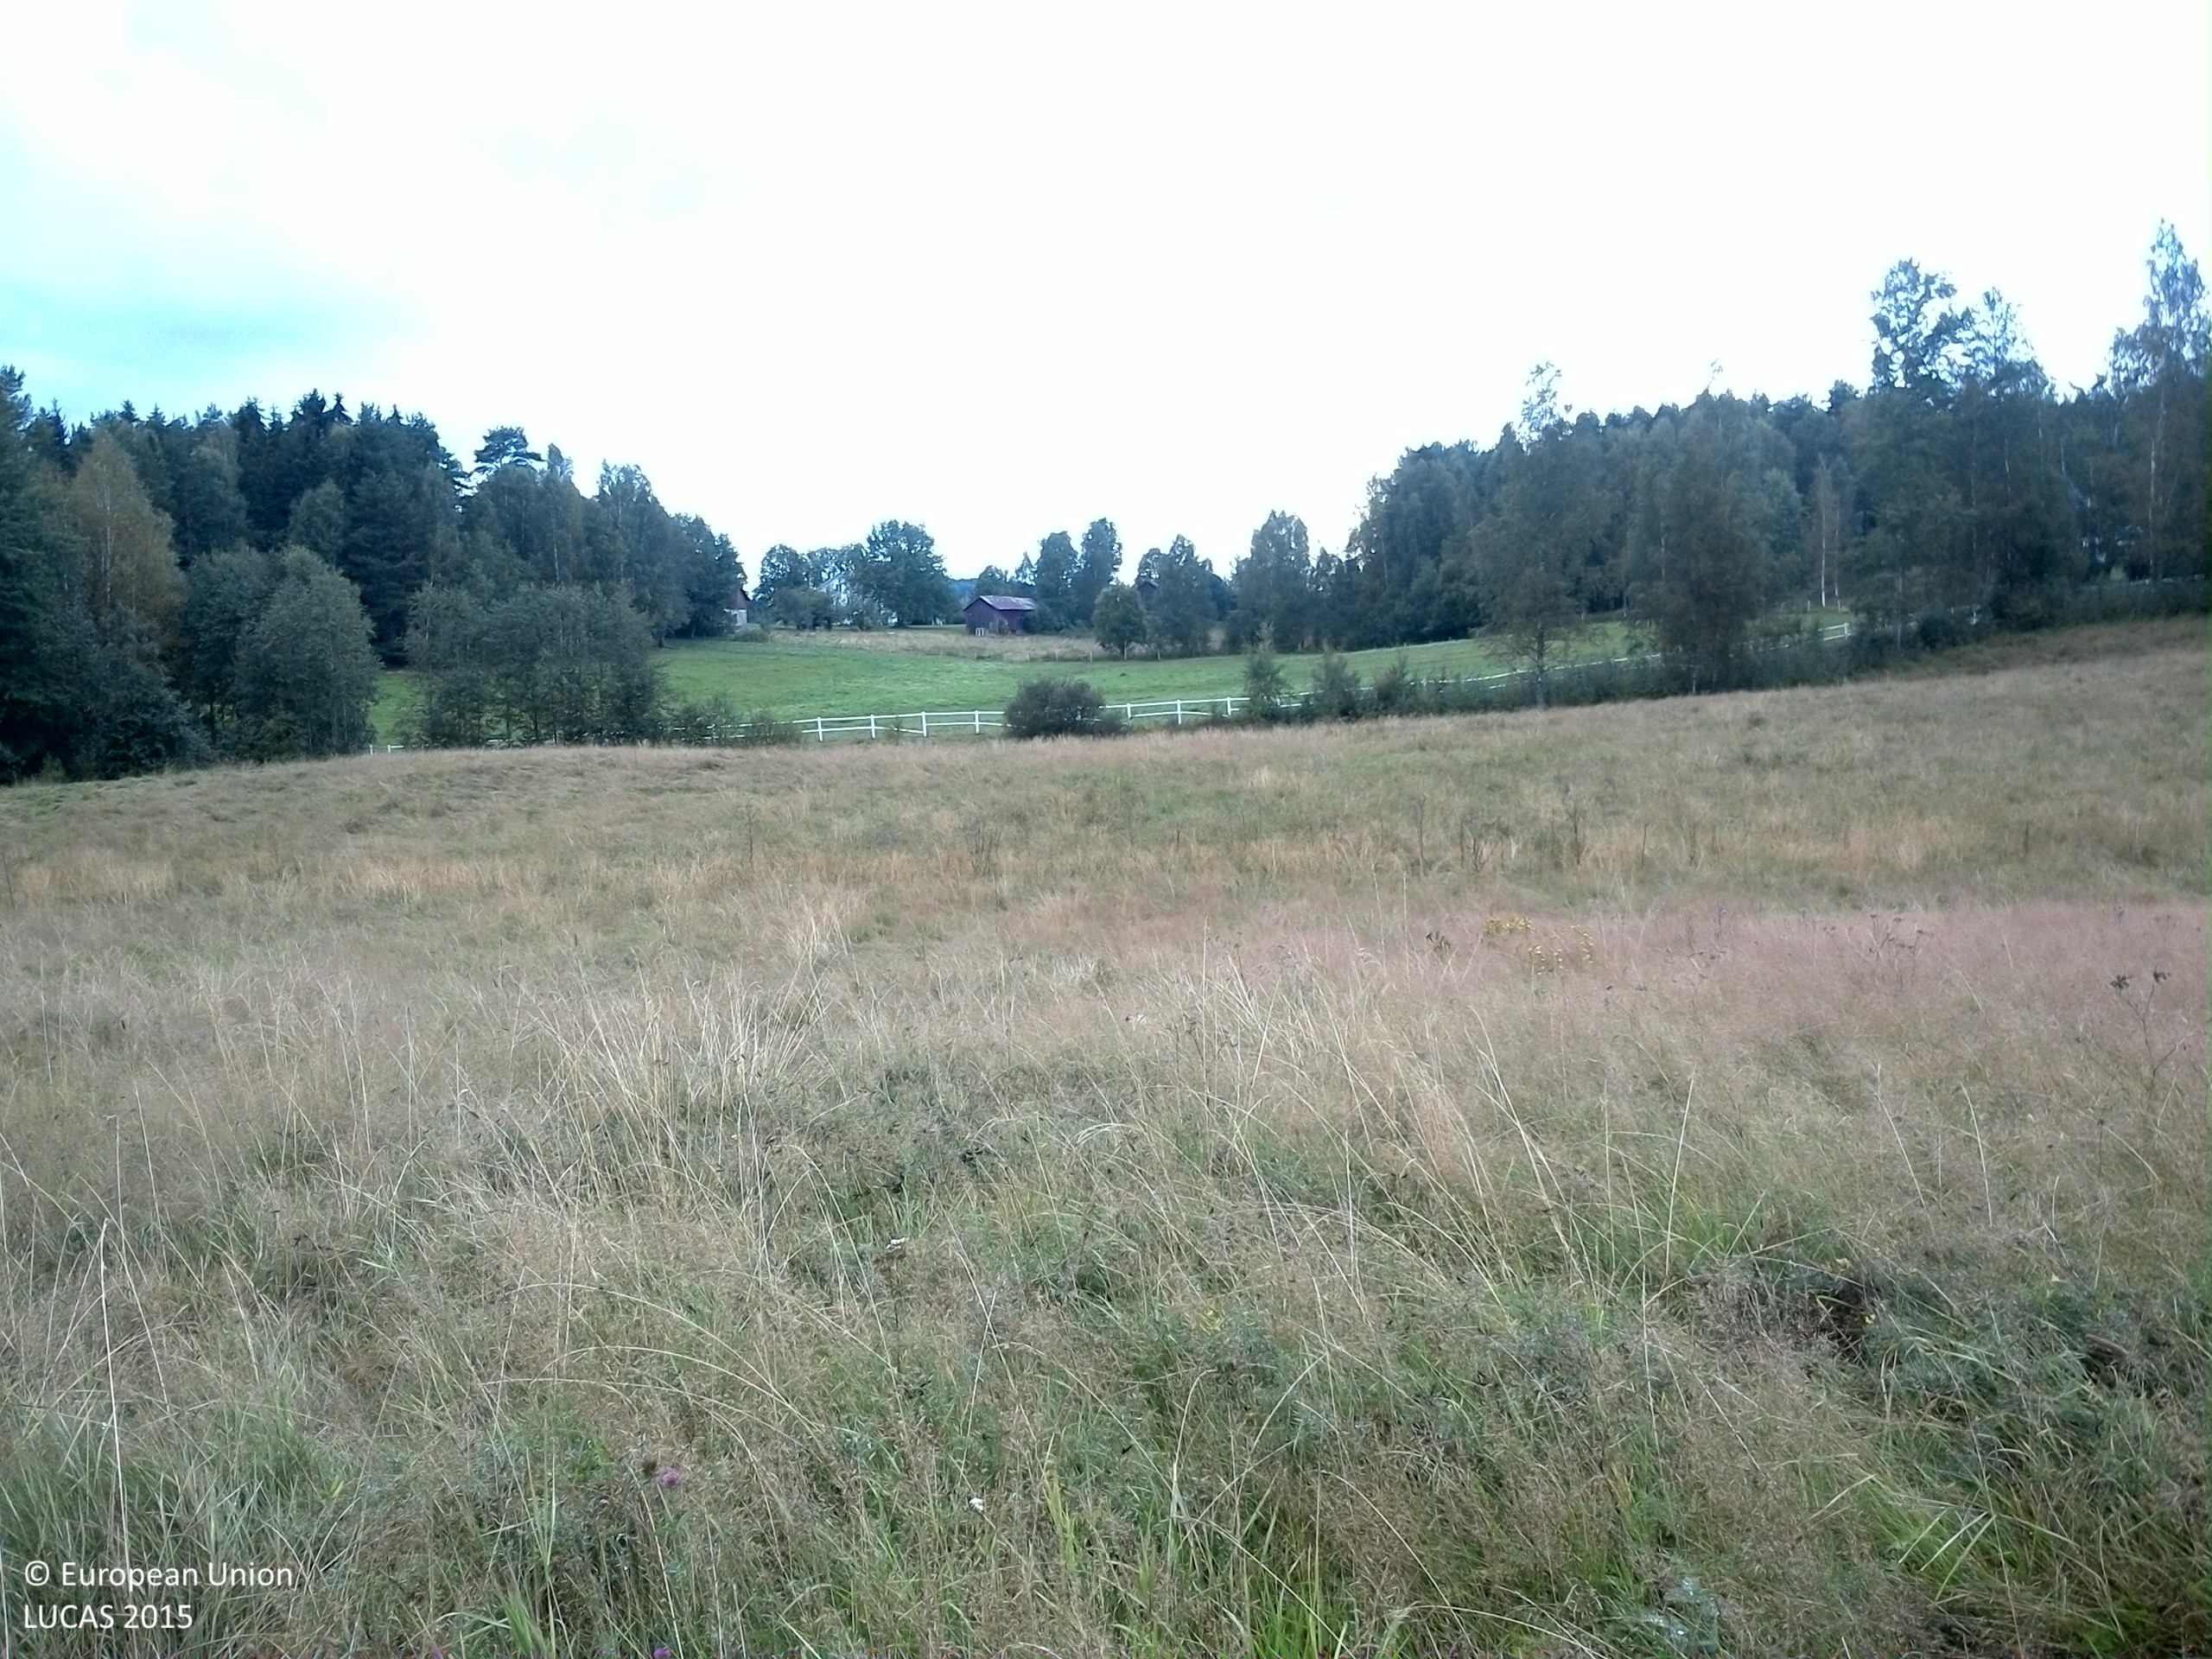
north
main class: Grassland
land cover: Grassland without tree/shrub cover
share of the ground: > 75 %
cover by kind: herbaceous plants 90 %, consolidated bare surface 10 %
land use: Agriculture (excluding fallow land and kitchen gardens)
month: September
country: SE
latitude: 59.3517
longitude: 12.2982
